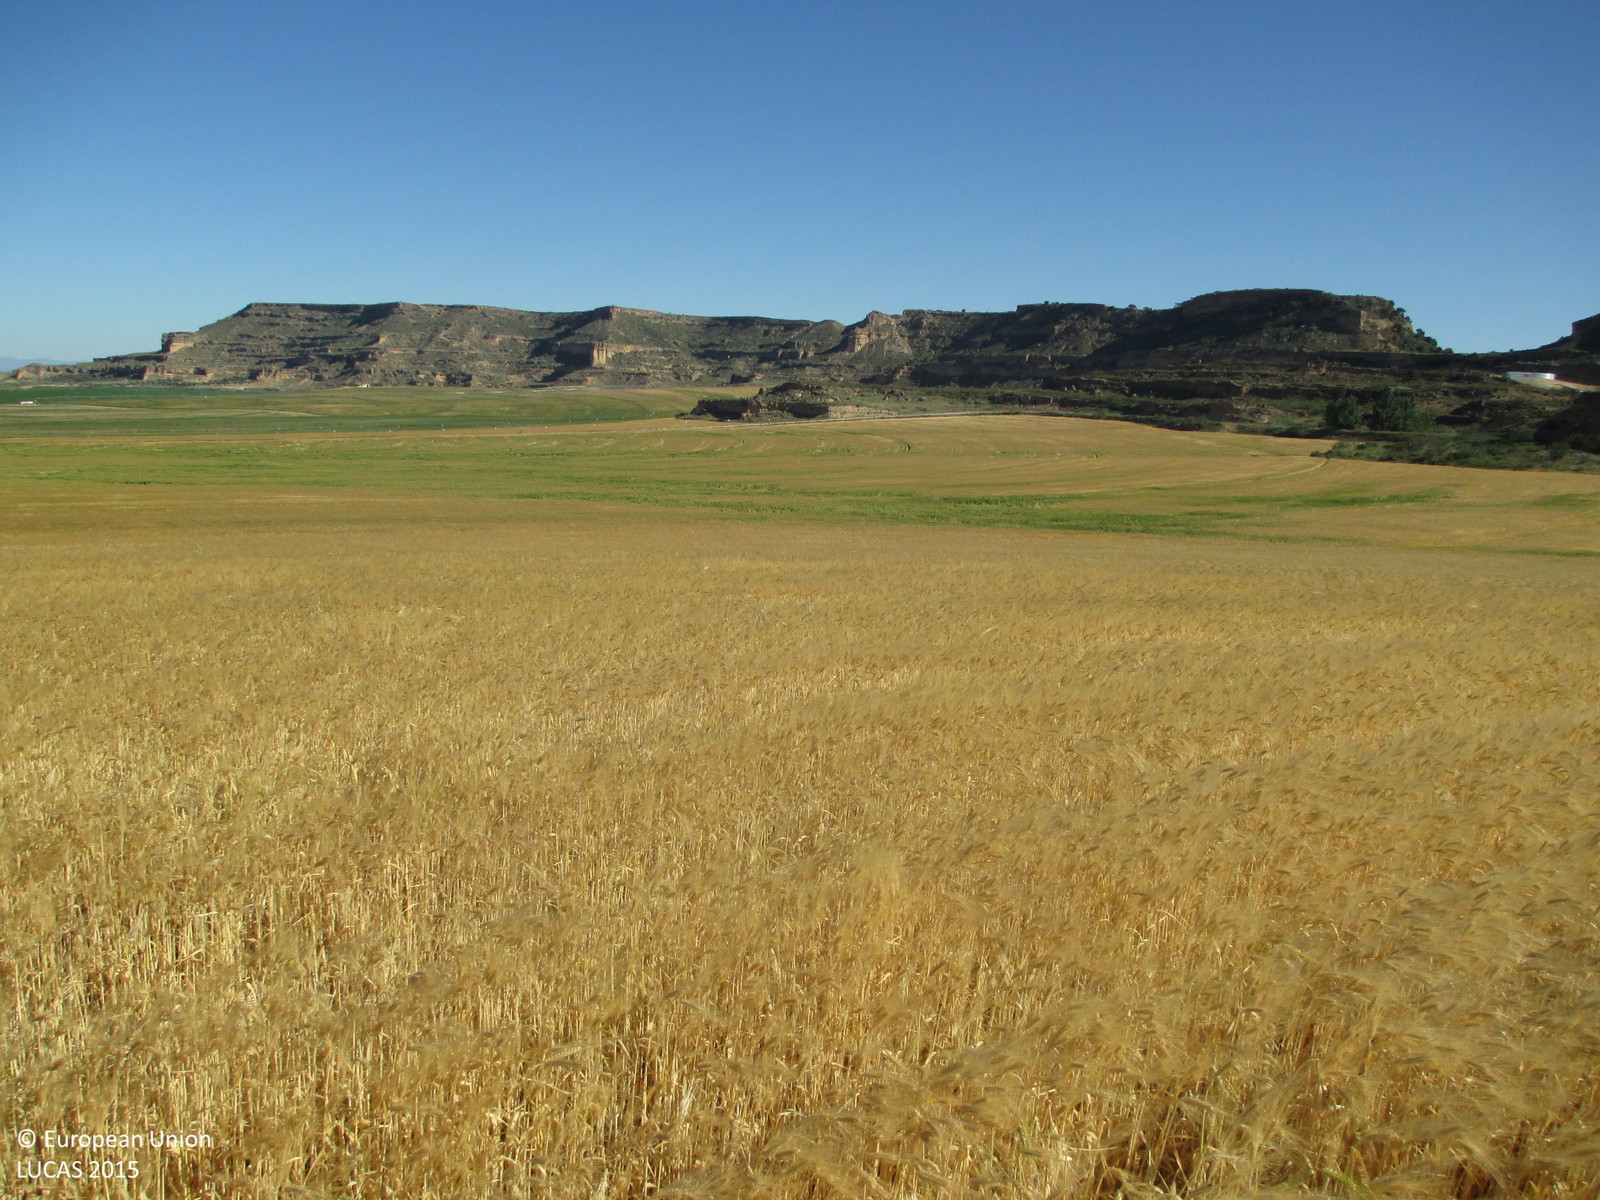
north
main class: Cropland
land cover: Barley
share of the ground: > 75 %
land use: Agriculture (excluding fallow land and kitchen gardens)
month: May
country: ES
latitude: 41.9138
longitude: -0.2556
